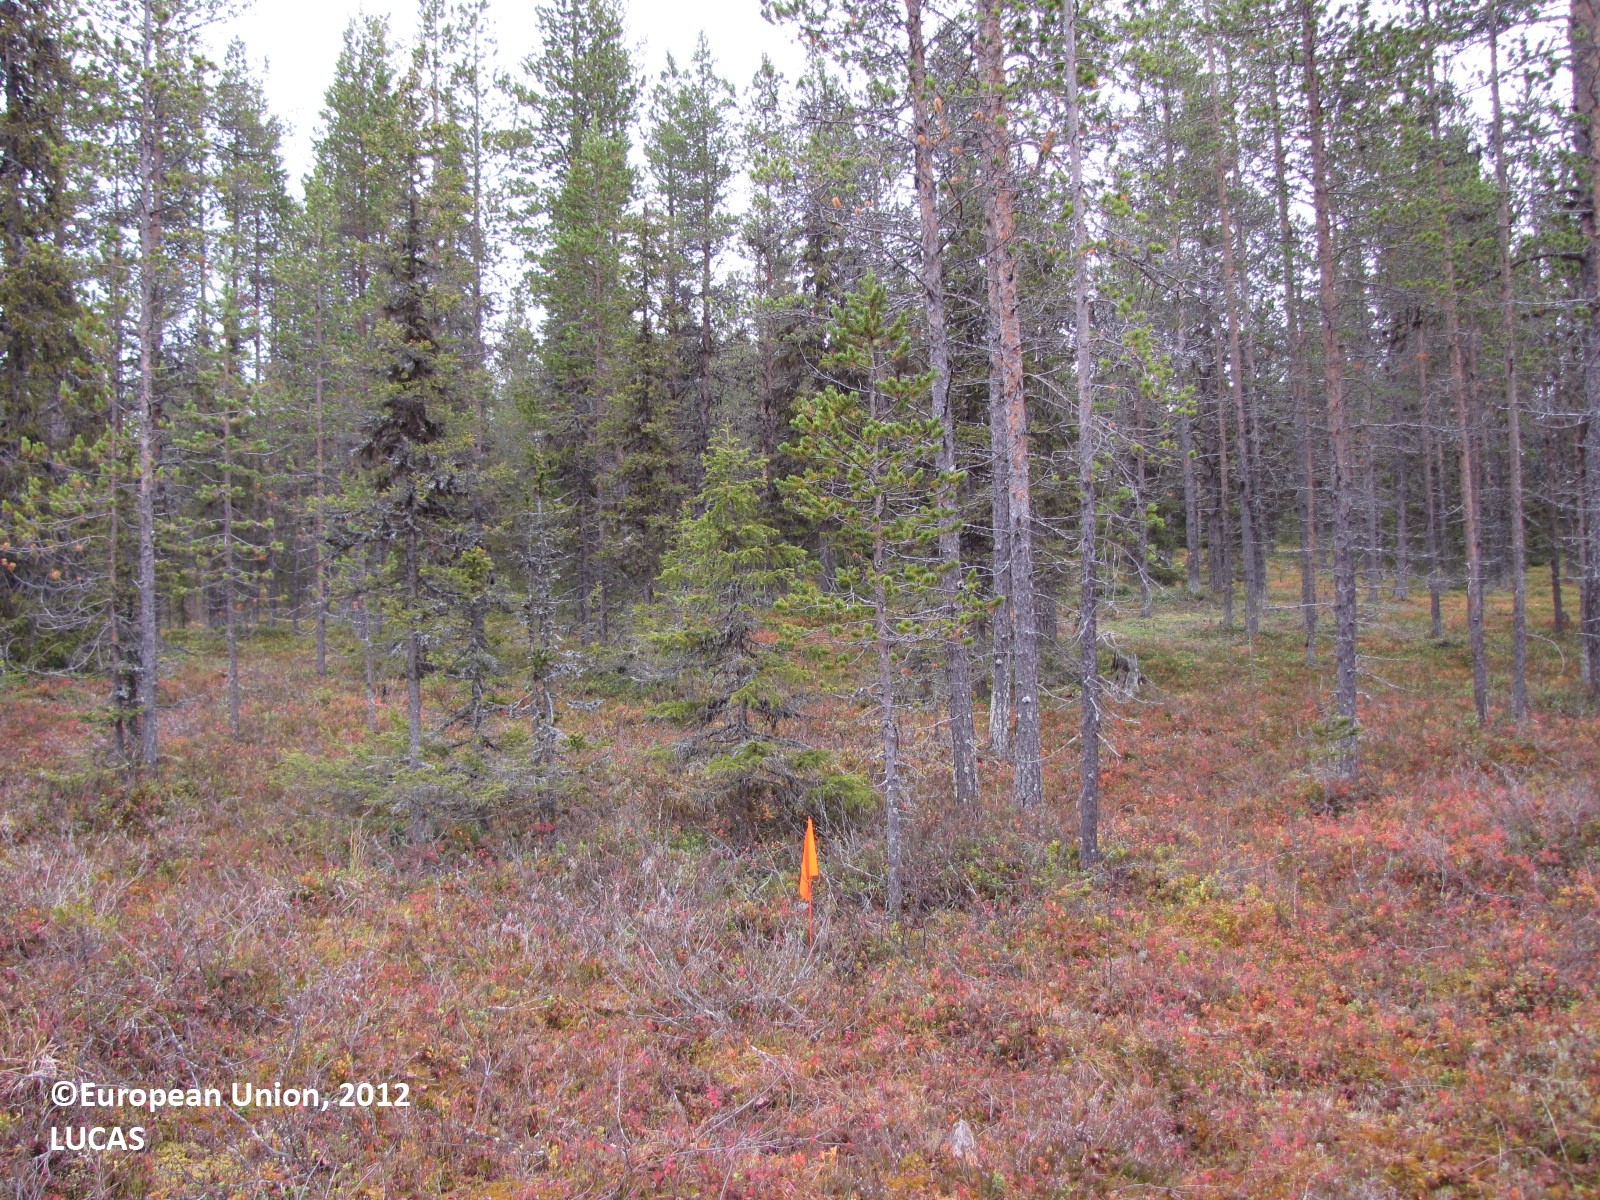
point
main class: Woodland
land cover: Pine dominated coniferous woodland
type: boreal forest
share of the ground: 25 - 50 %
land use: Forestry
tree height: > 5 m
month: September
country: FI
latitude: 67.8347
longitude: 23.9597
